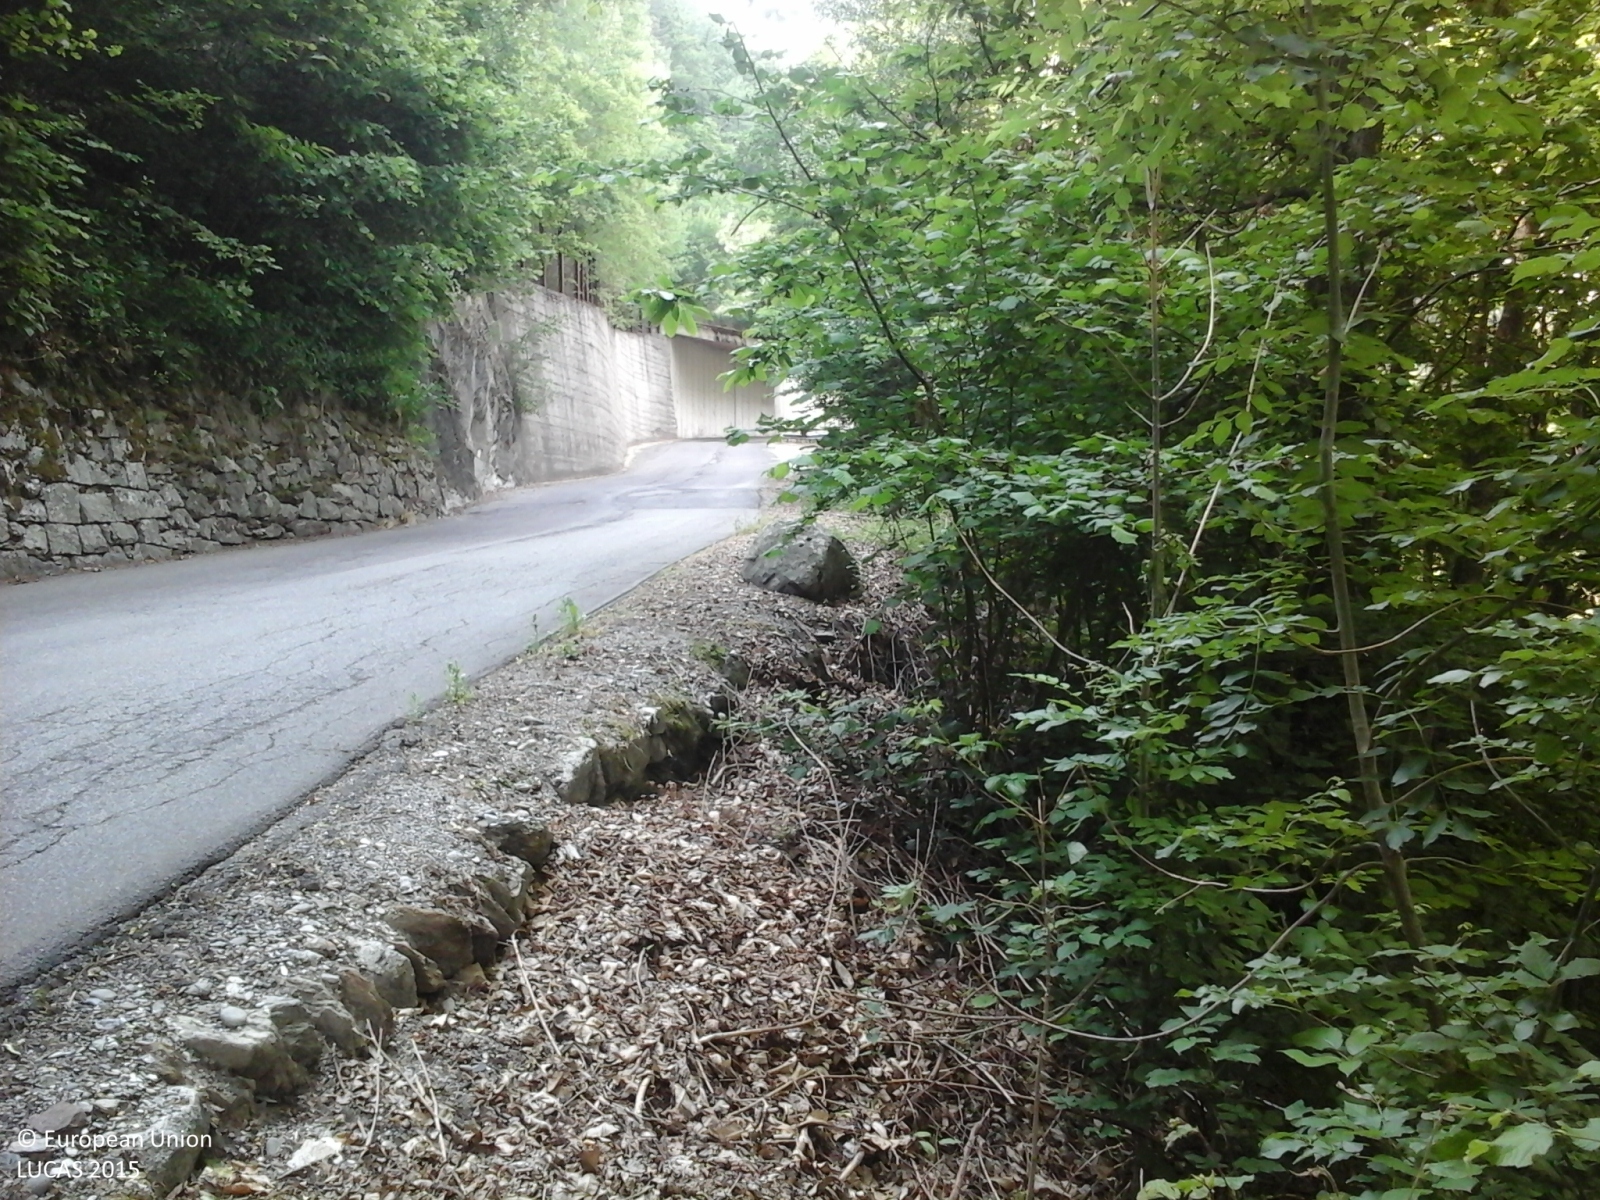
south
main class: Woodland
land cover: Broadleaved woodland
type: thermophilous deciduous forest
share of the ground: > 75 %
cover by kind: broadleaved forest trees 100 %
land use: Semi-natural and natural areas not in use
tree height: > 5 m
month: June
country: IT
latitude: 46.1345
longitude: 10.3490
